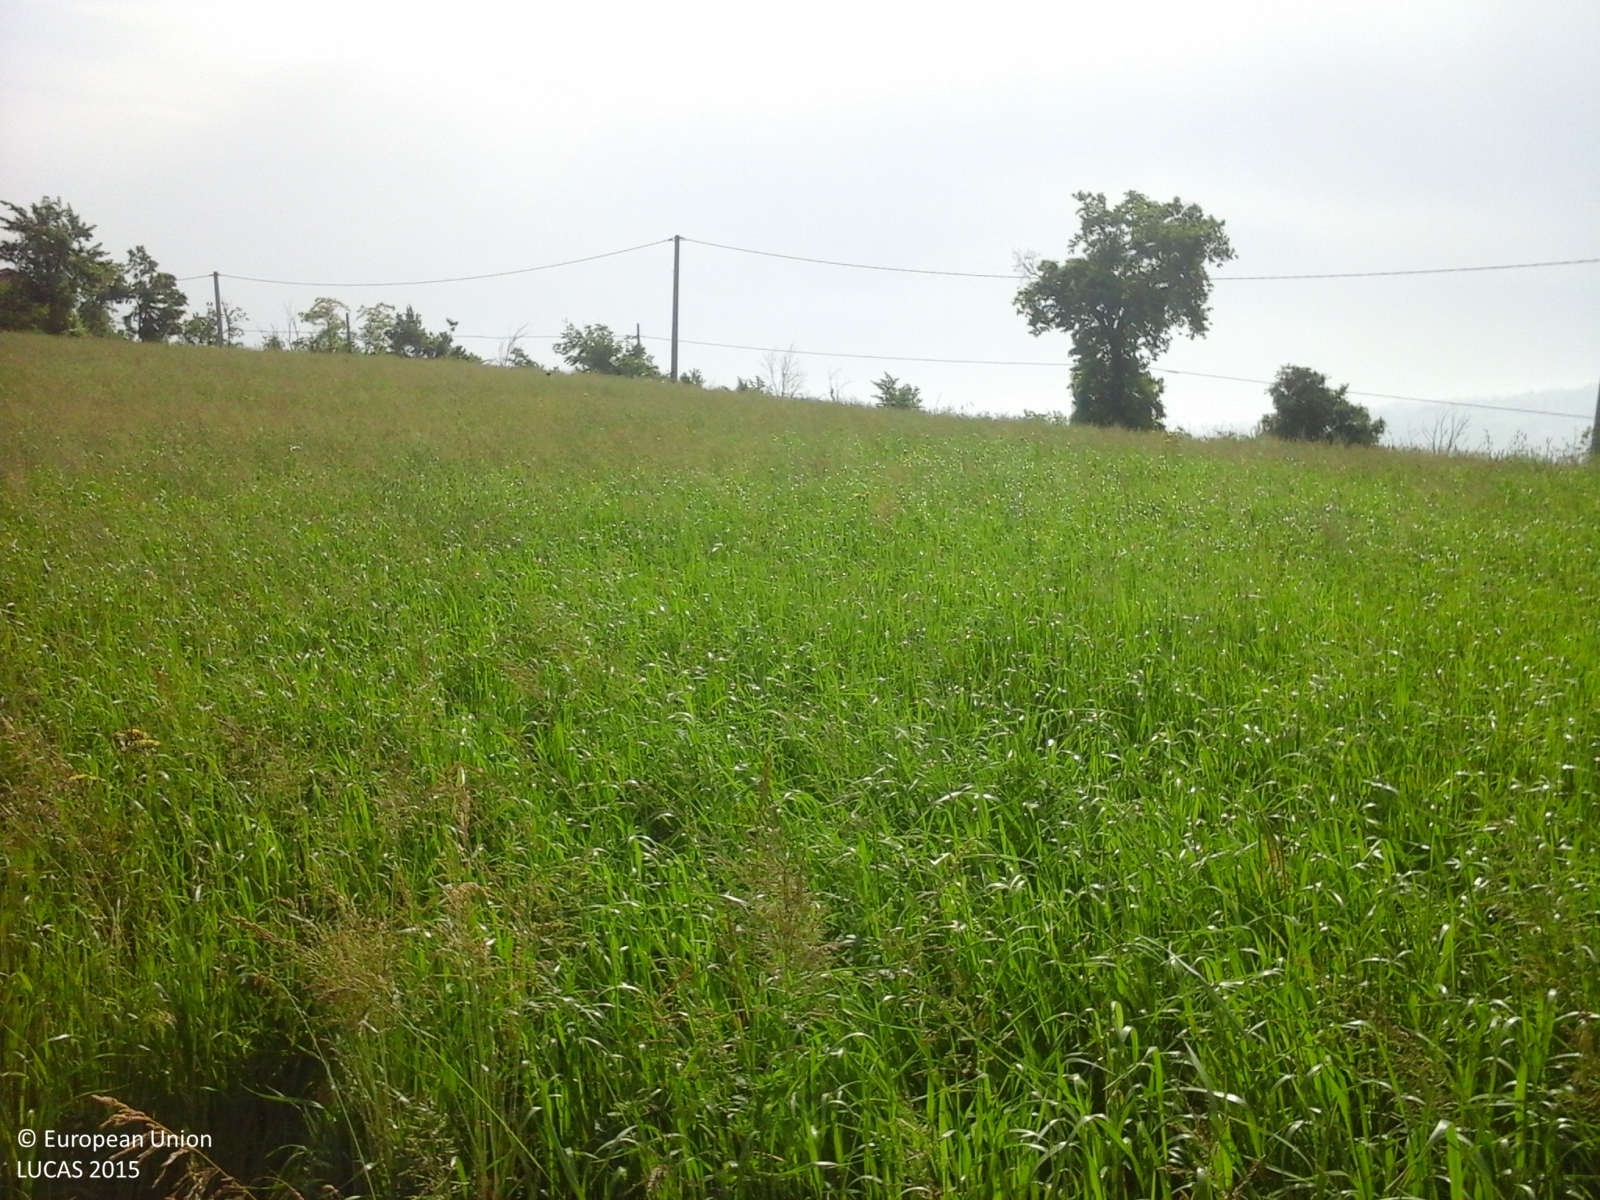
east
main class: Cropland
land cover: Lucerne
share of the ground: > 75 %
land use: Agriculture (excluding fallow land and kitchen gardens)
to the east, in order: Lucerne; Electric lines; Abandoned hedges; Paved roads, cycling and walking lanes; Abandoned hedges; Electric lines; Grassland without tree/shrub cover; Abandoned hedges; Paved roads, cycling and walking lanes
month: May
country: IT
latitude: 44.4545
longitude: 10.9404
